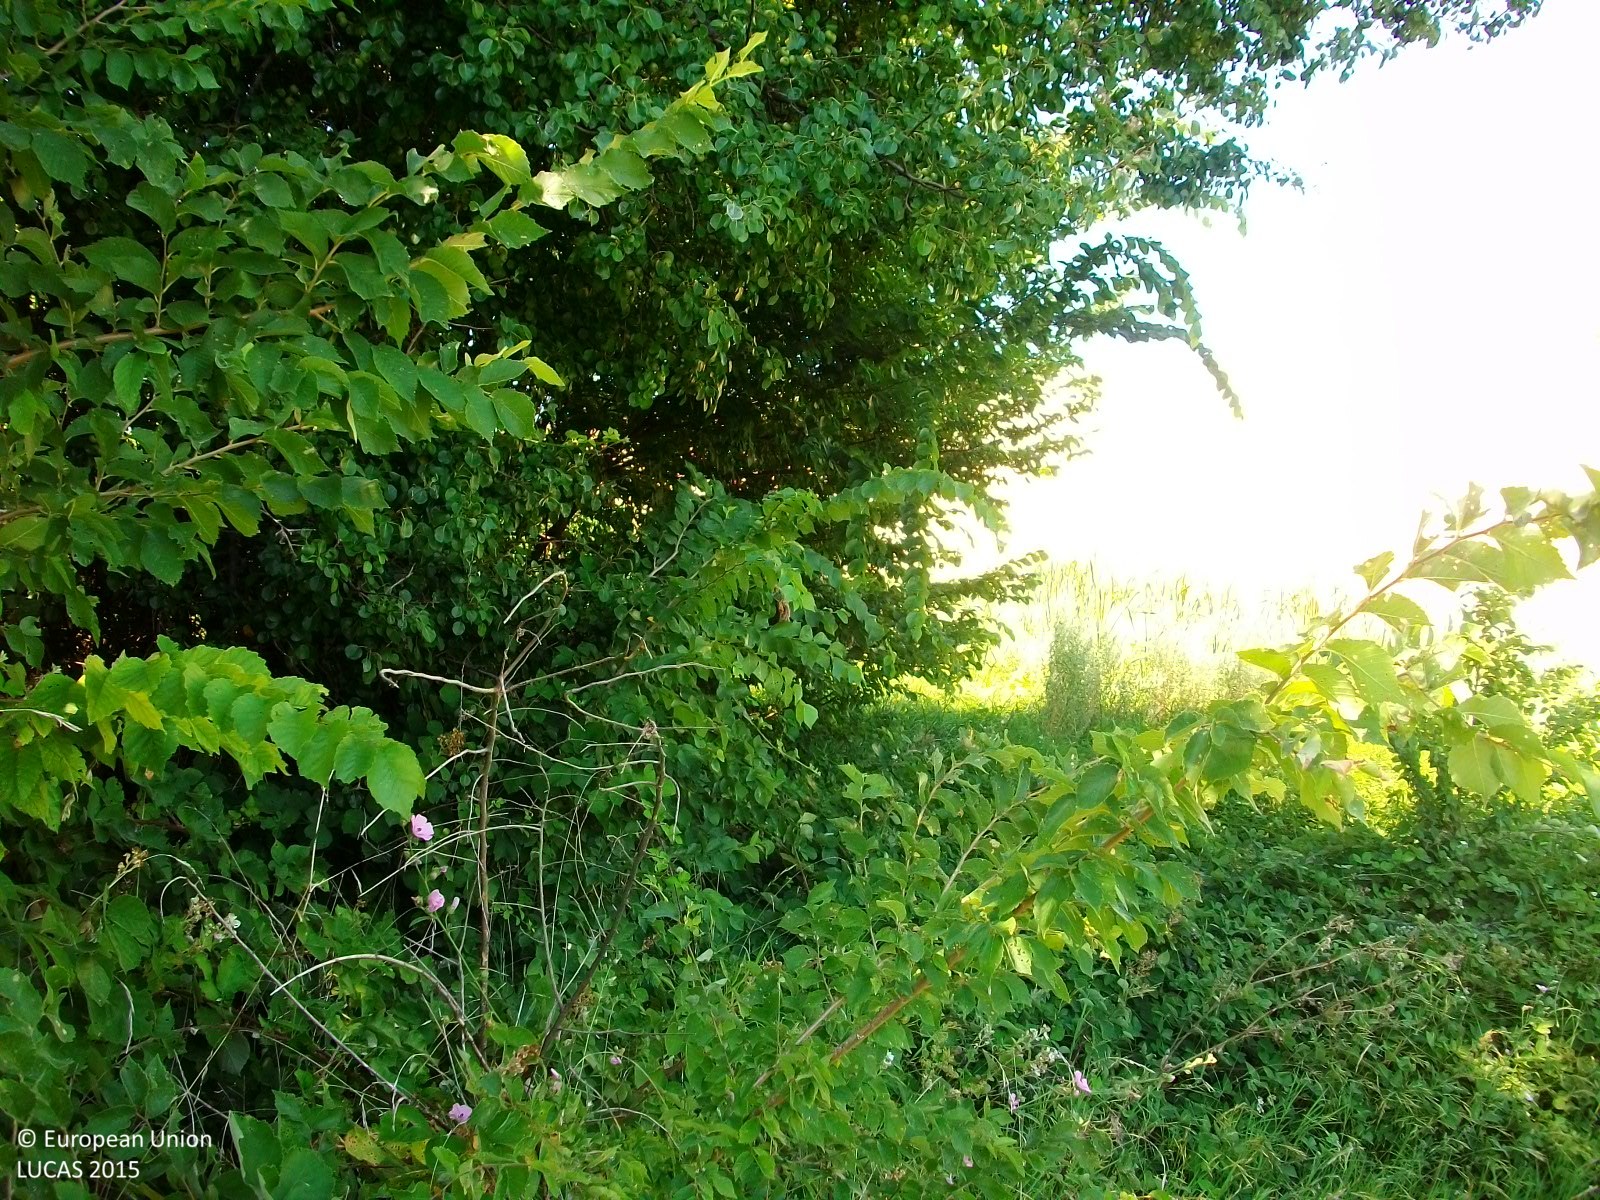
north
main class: Grassland
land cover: Spontaneously vegetated surfaces
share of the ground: > 75 %
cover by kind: herbaceous plants 95 %, shrubs 5 %
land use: Fallow land
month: July
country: GR
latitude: 41.4959
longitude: 26.2565
